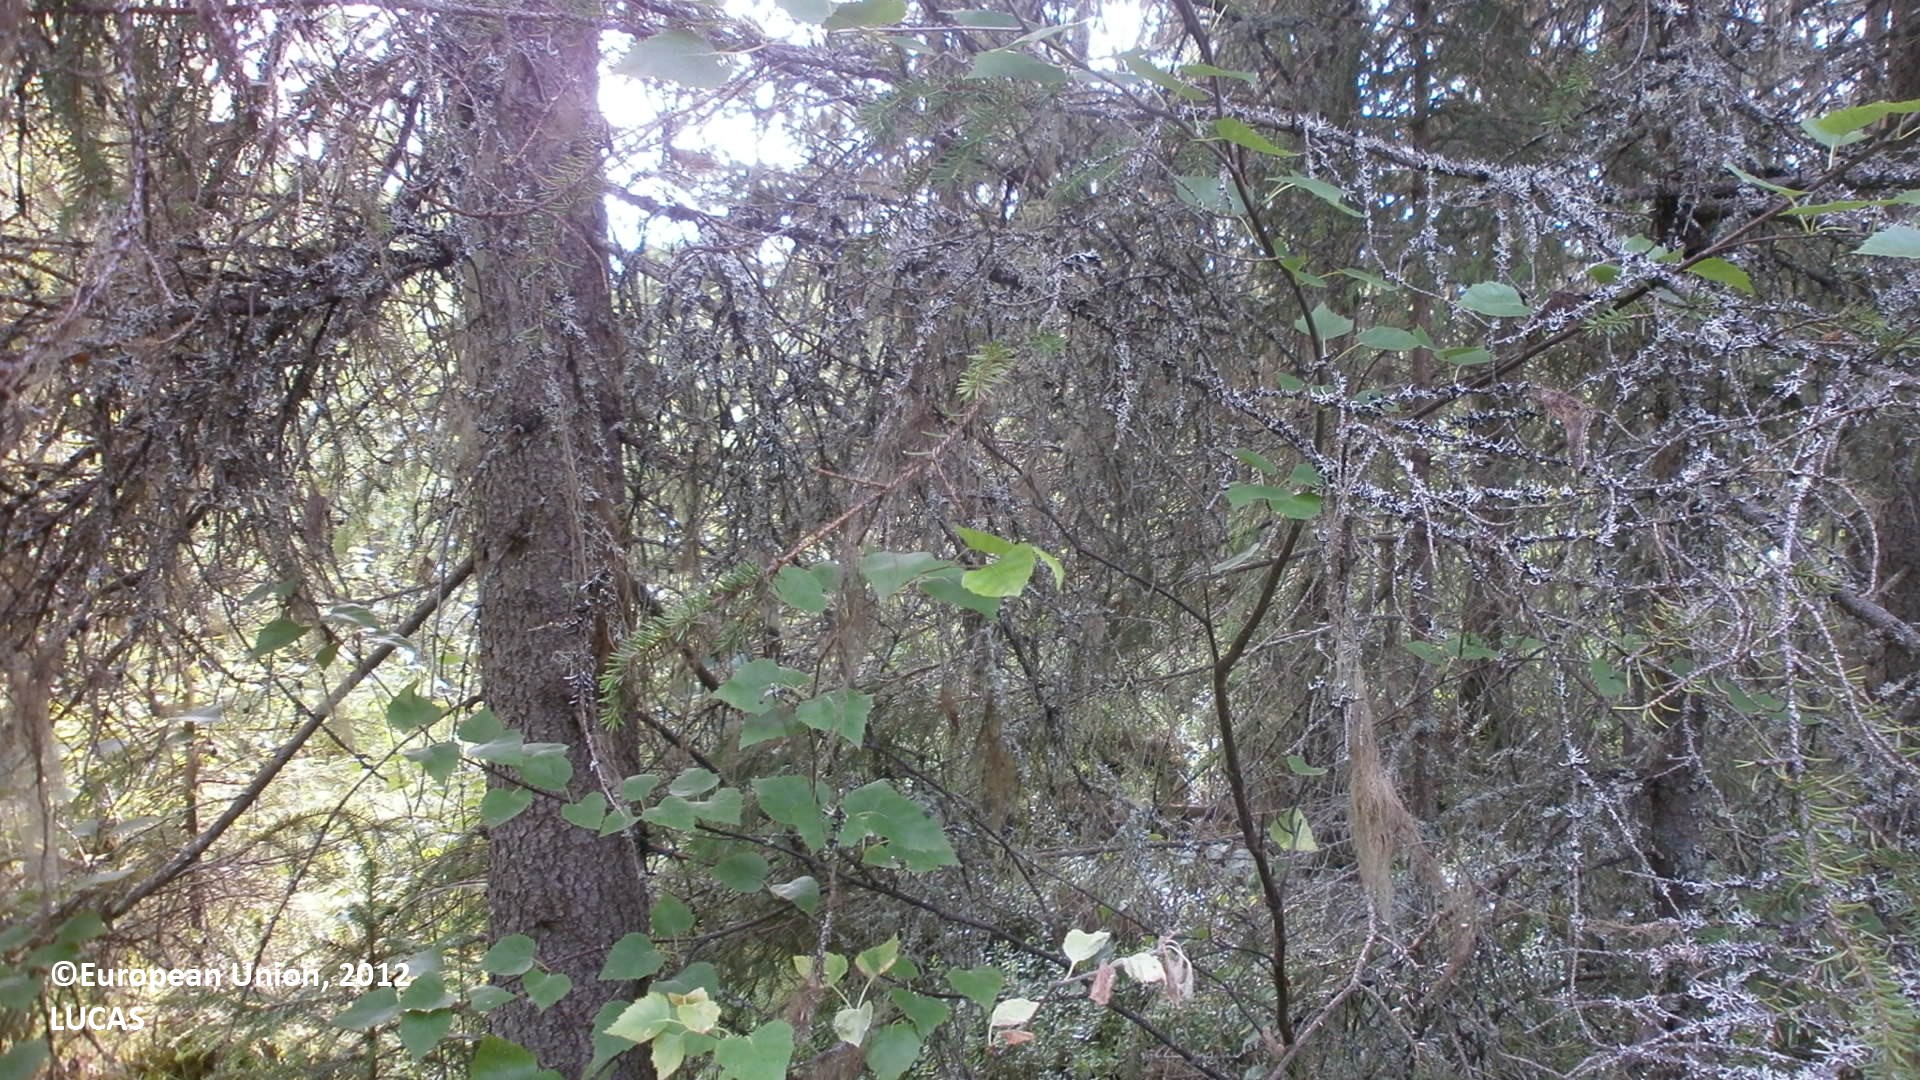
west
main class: Woodland
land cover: Spruce dominated mixed woodland
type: boreal forest
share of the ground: 50 - 75 %
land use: Forestry
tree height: > 5 m
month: July
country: FI
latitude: 64.3369
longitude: 24.2846
